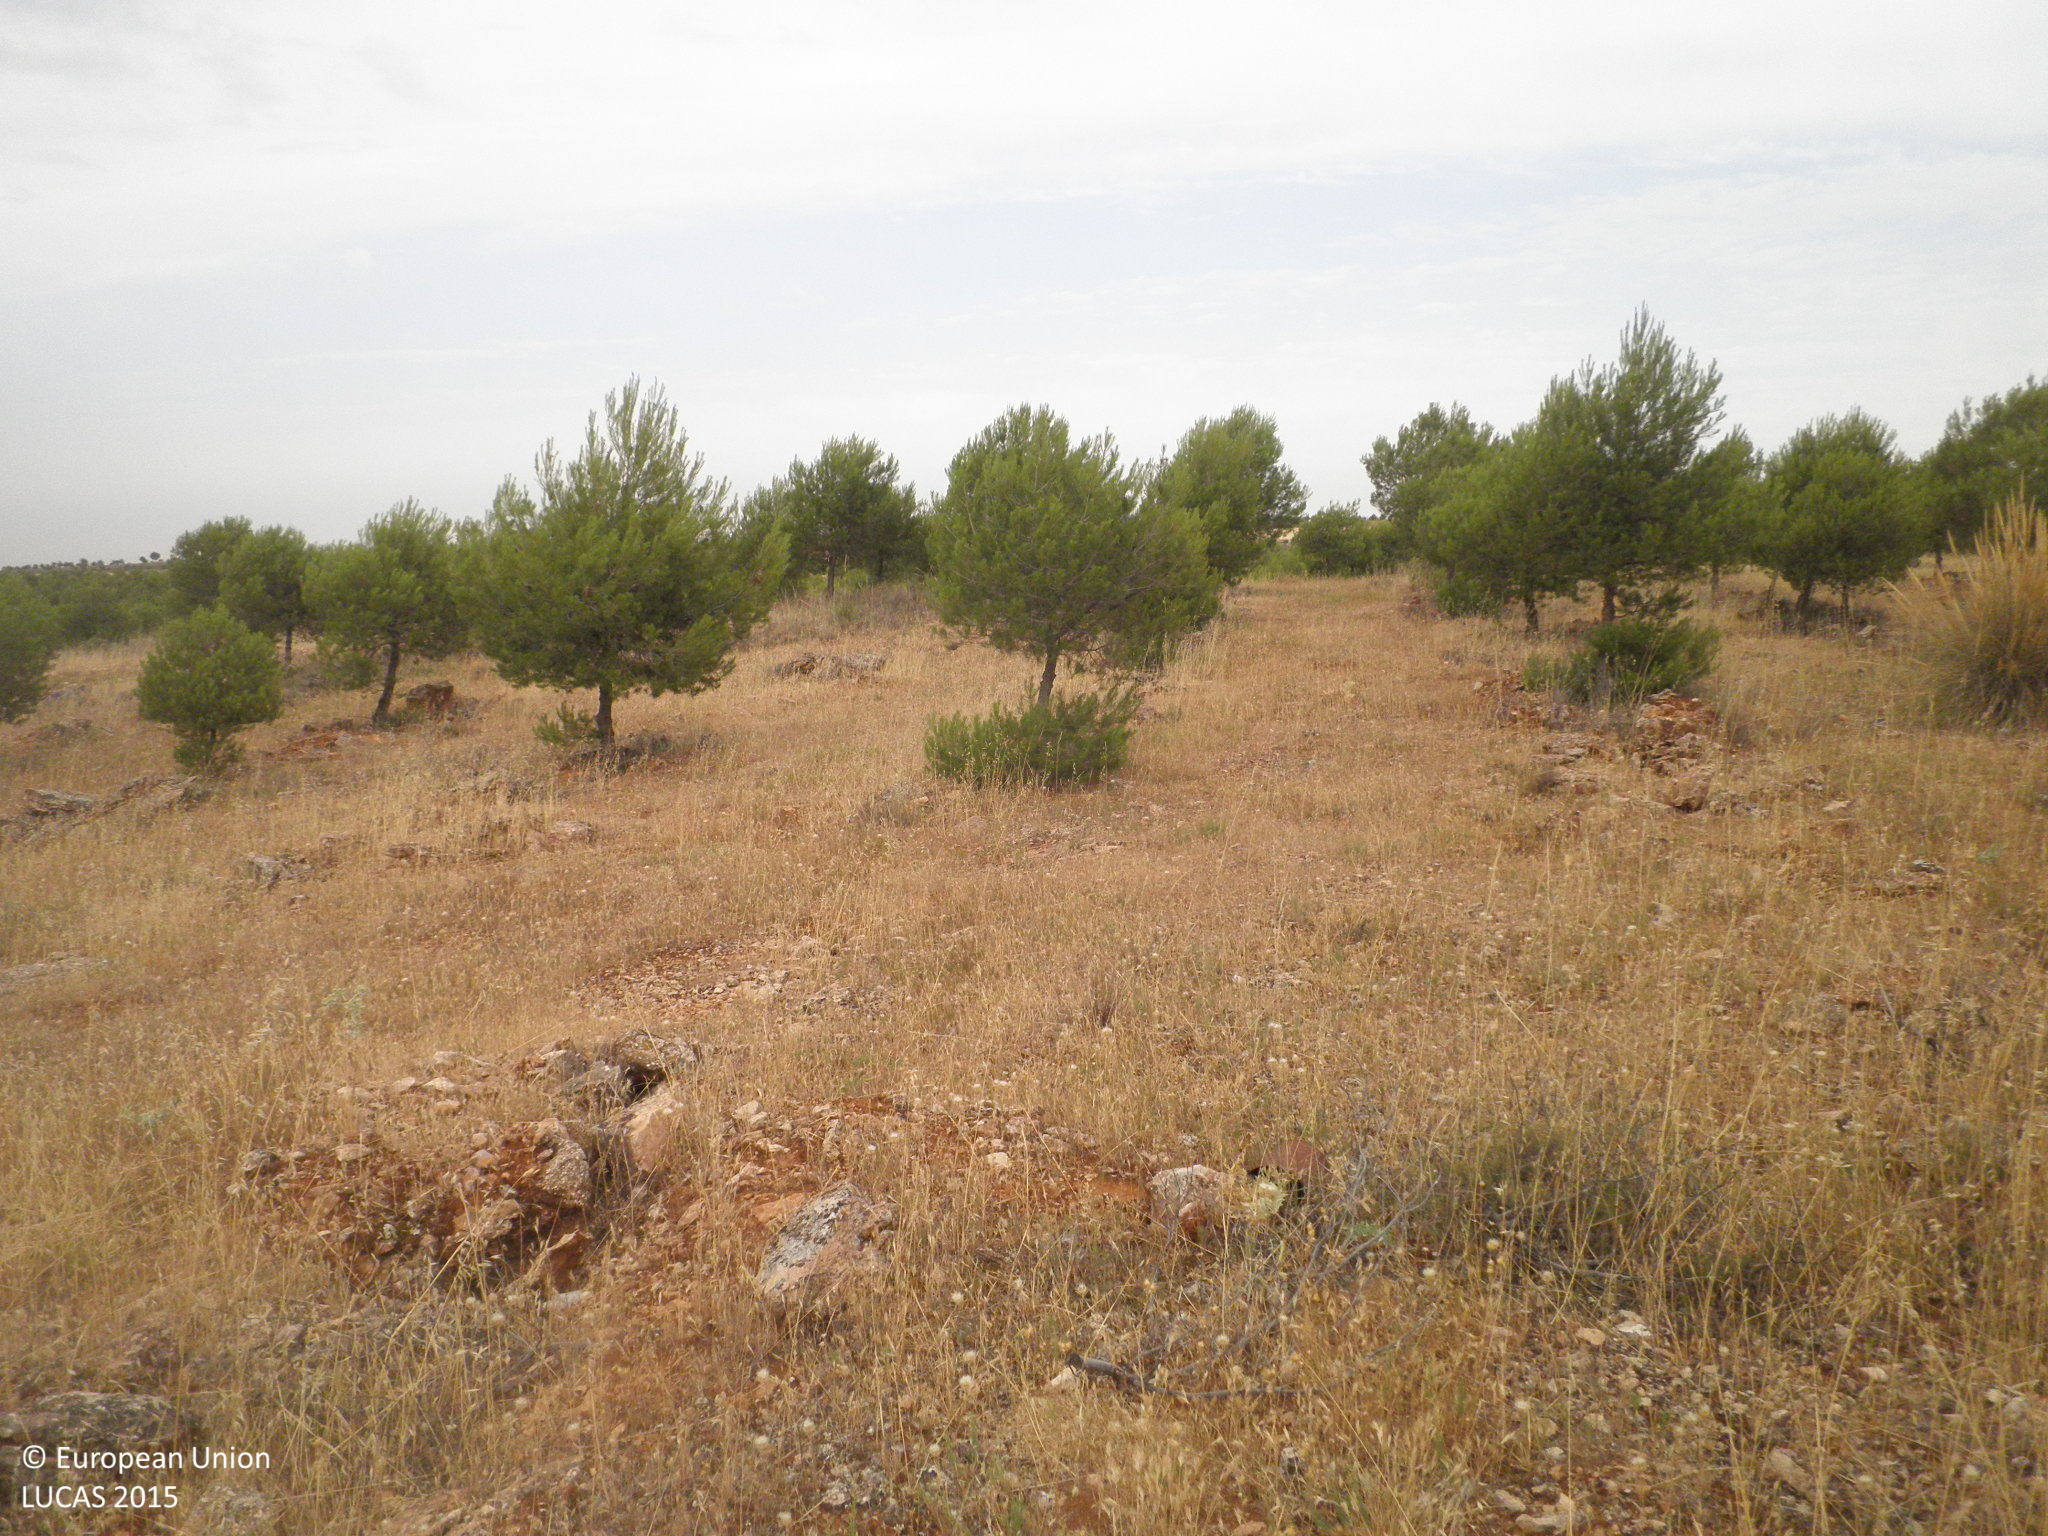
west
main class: Woodland
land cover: Pine dominated coniferous woodland
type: coniferous forest of the mediterranean region
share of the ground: 10 - 25 %
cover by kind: herbaceous plants 75 %, coniferous forest trees 10 %, consolidated bare surface 10 %, shrubs 5 %
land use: Semi-natural and natural areas not in use
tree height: < 5 m
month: July
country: ES
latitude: 39.4784
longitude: -2.6735
